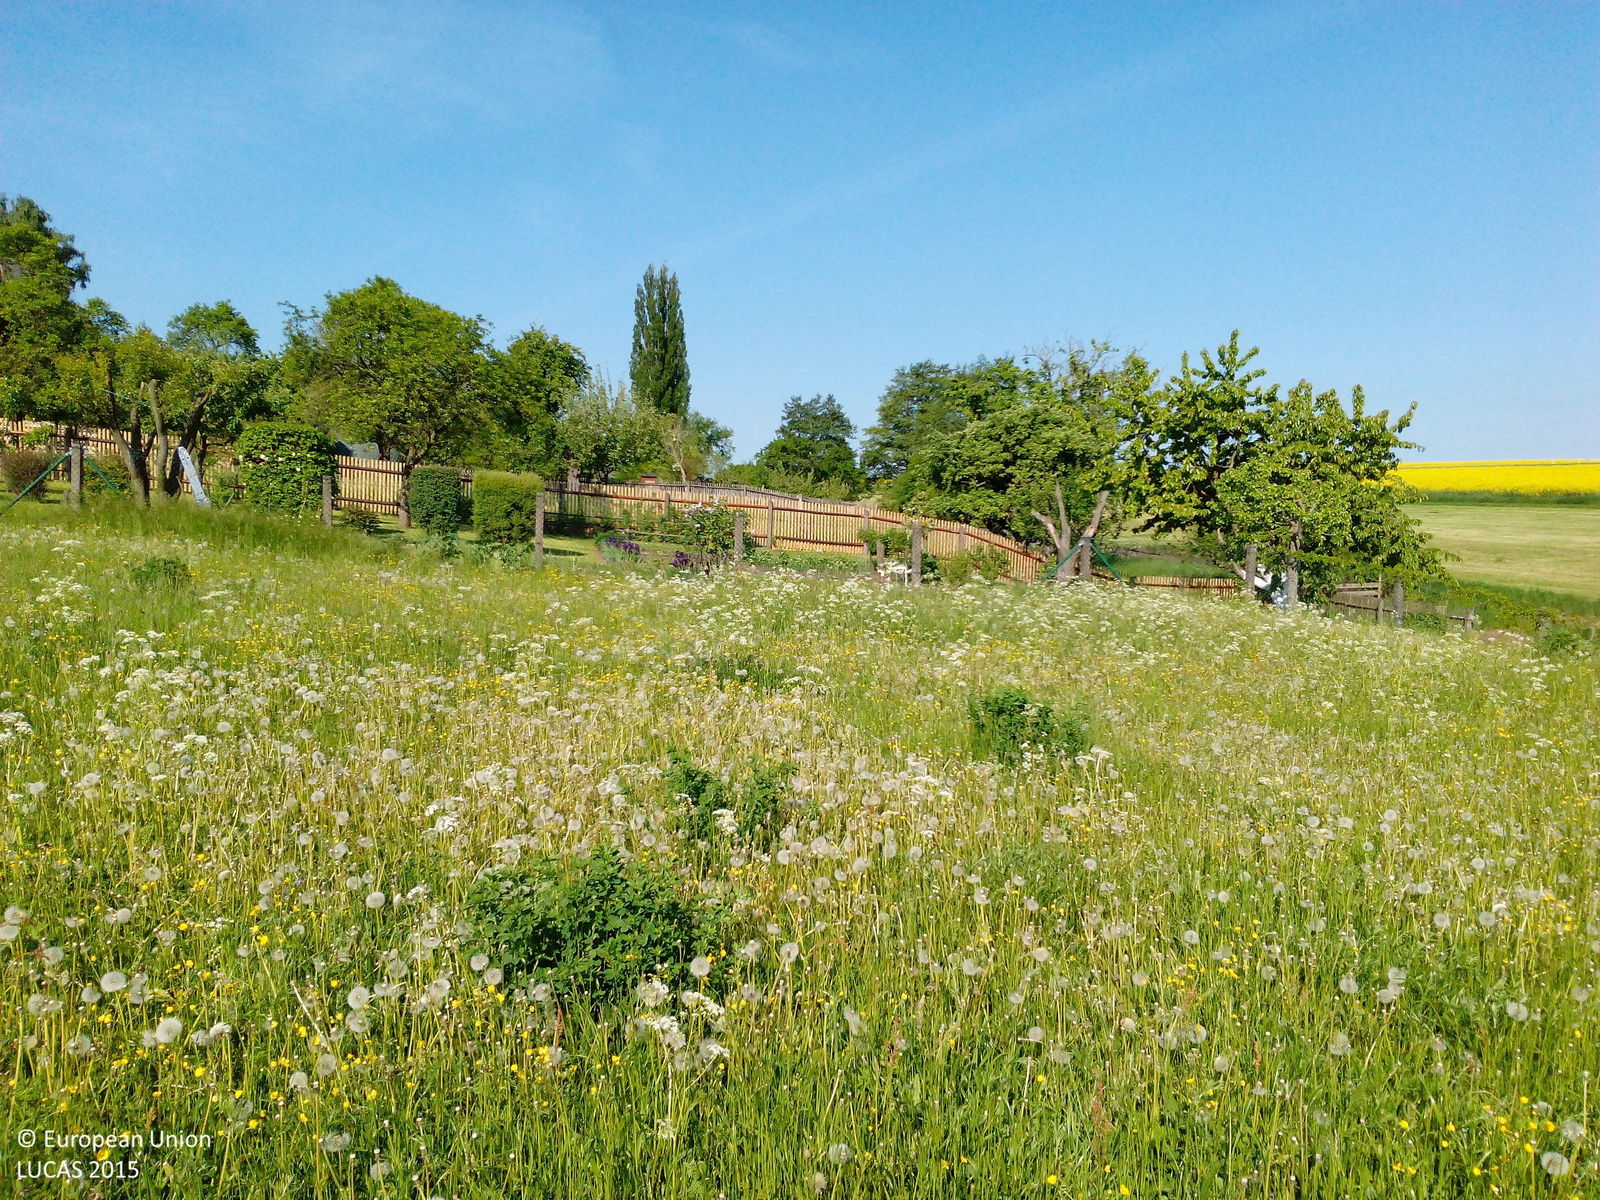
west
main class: Cropland
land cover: Apple fruit
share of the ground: 25 - 50 %
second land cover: Grassland without tree/shrub cover
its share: > 75 %
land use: Agriculture (excluding fallow land and kitchen gardens)
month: May
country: DE
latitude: 50.8582
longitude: 11.4629
